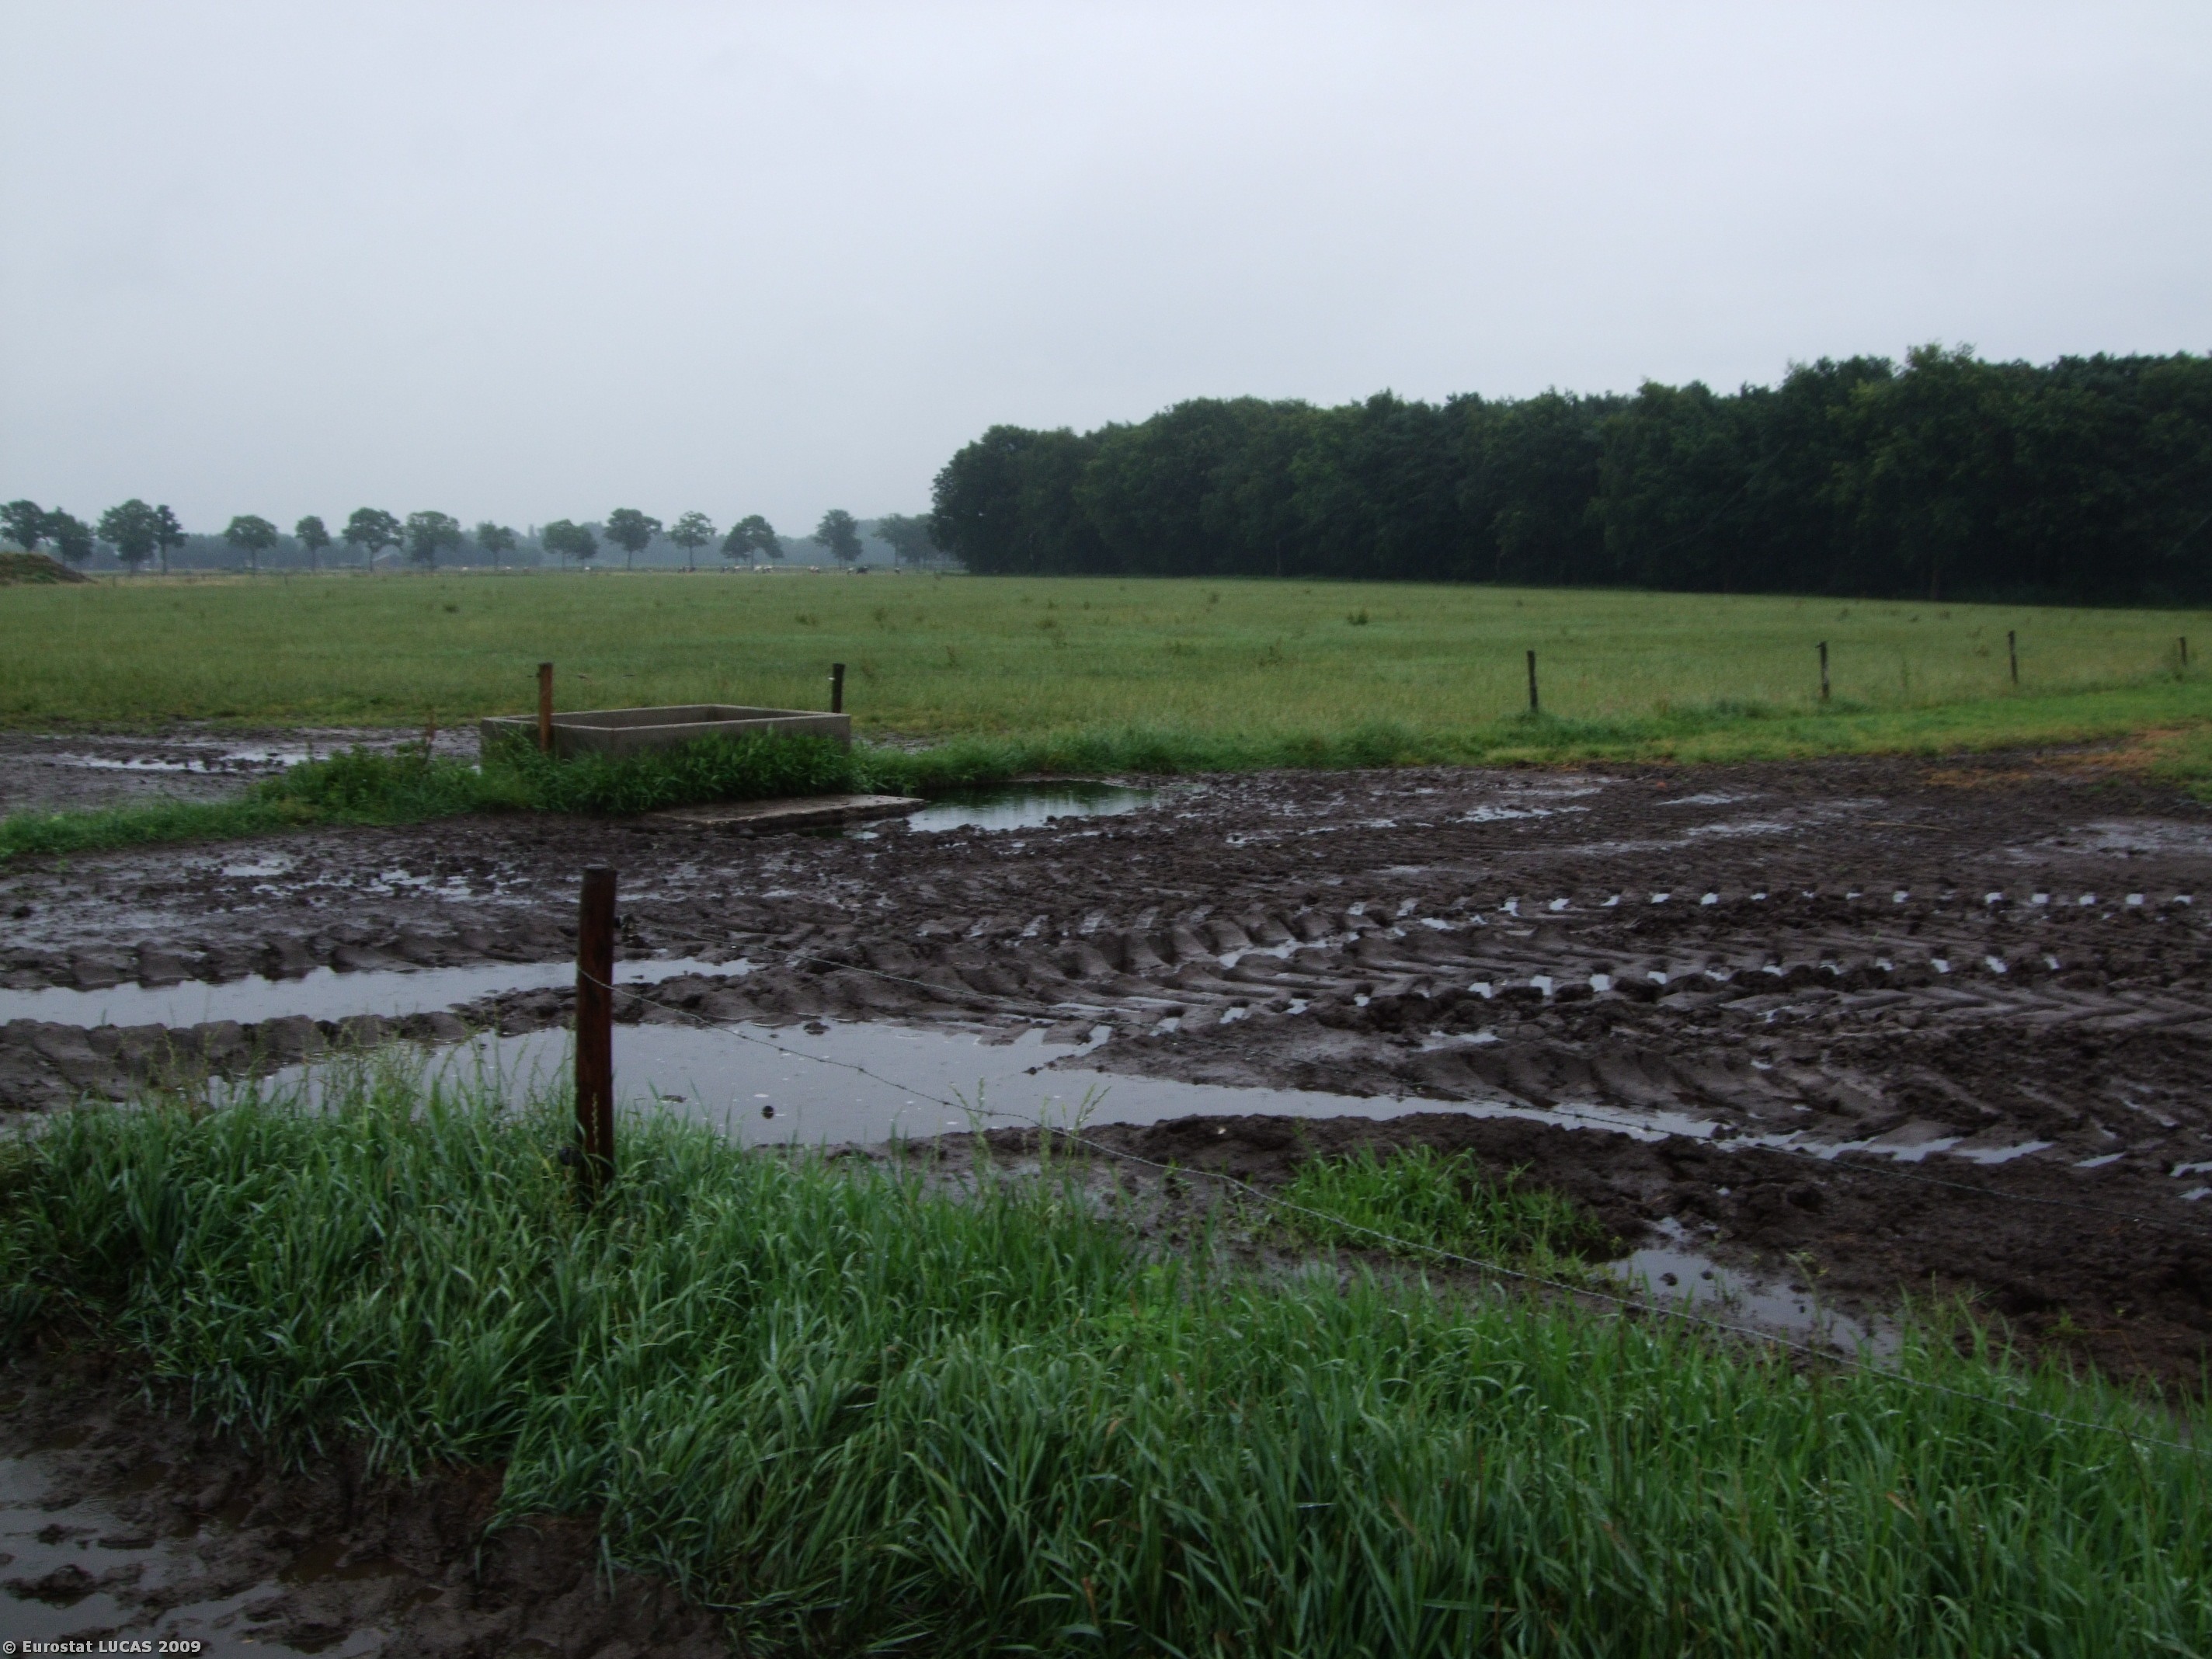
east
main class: Grassland
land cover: Grassland without tree/shrub cover
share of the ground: > 75 %
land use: Agriculture (excluding fallow land and kitchen gardens)
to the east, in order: Grassland without tree/shrub cover; Tracks; Fences; Grassland without tree/shrub cover
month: July
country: NL
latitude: 51.3099
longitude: 5.7091
